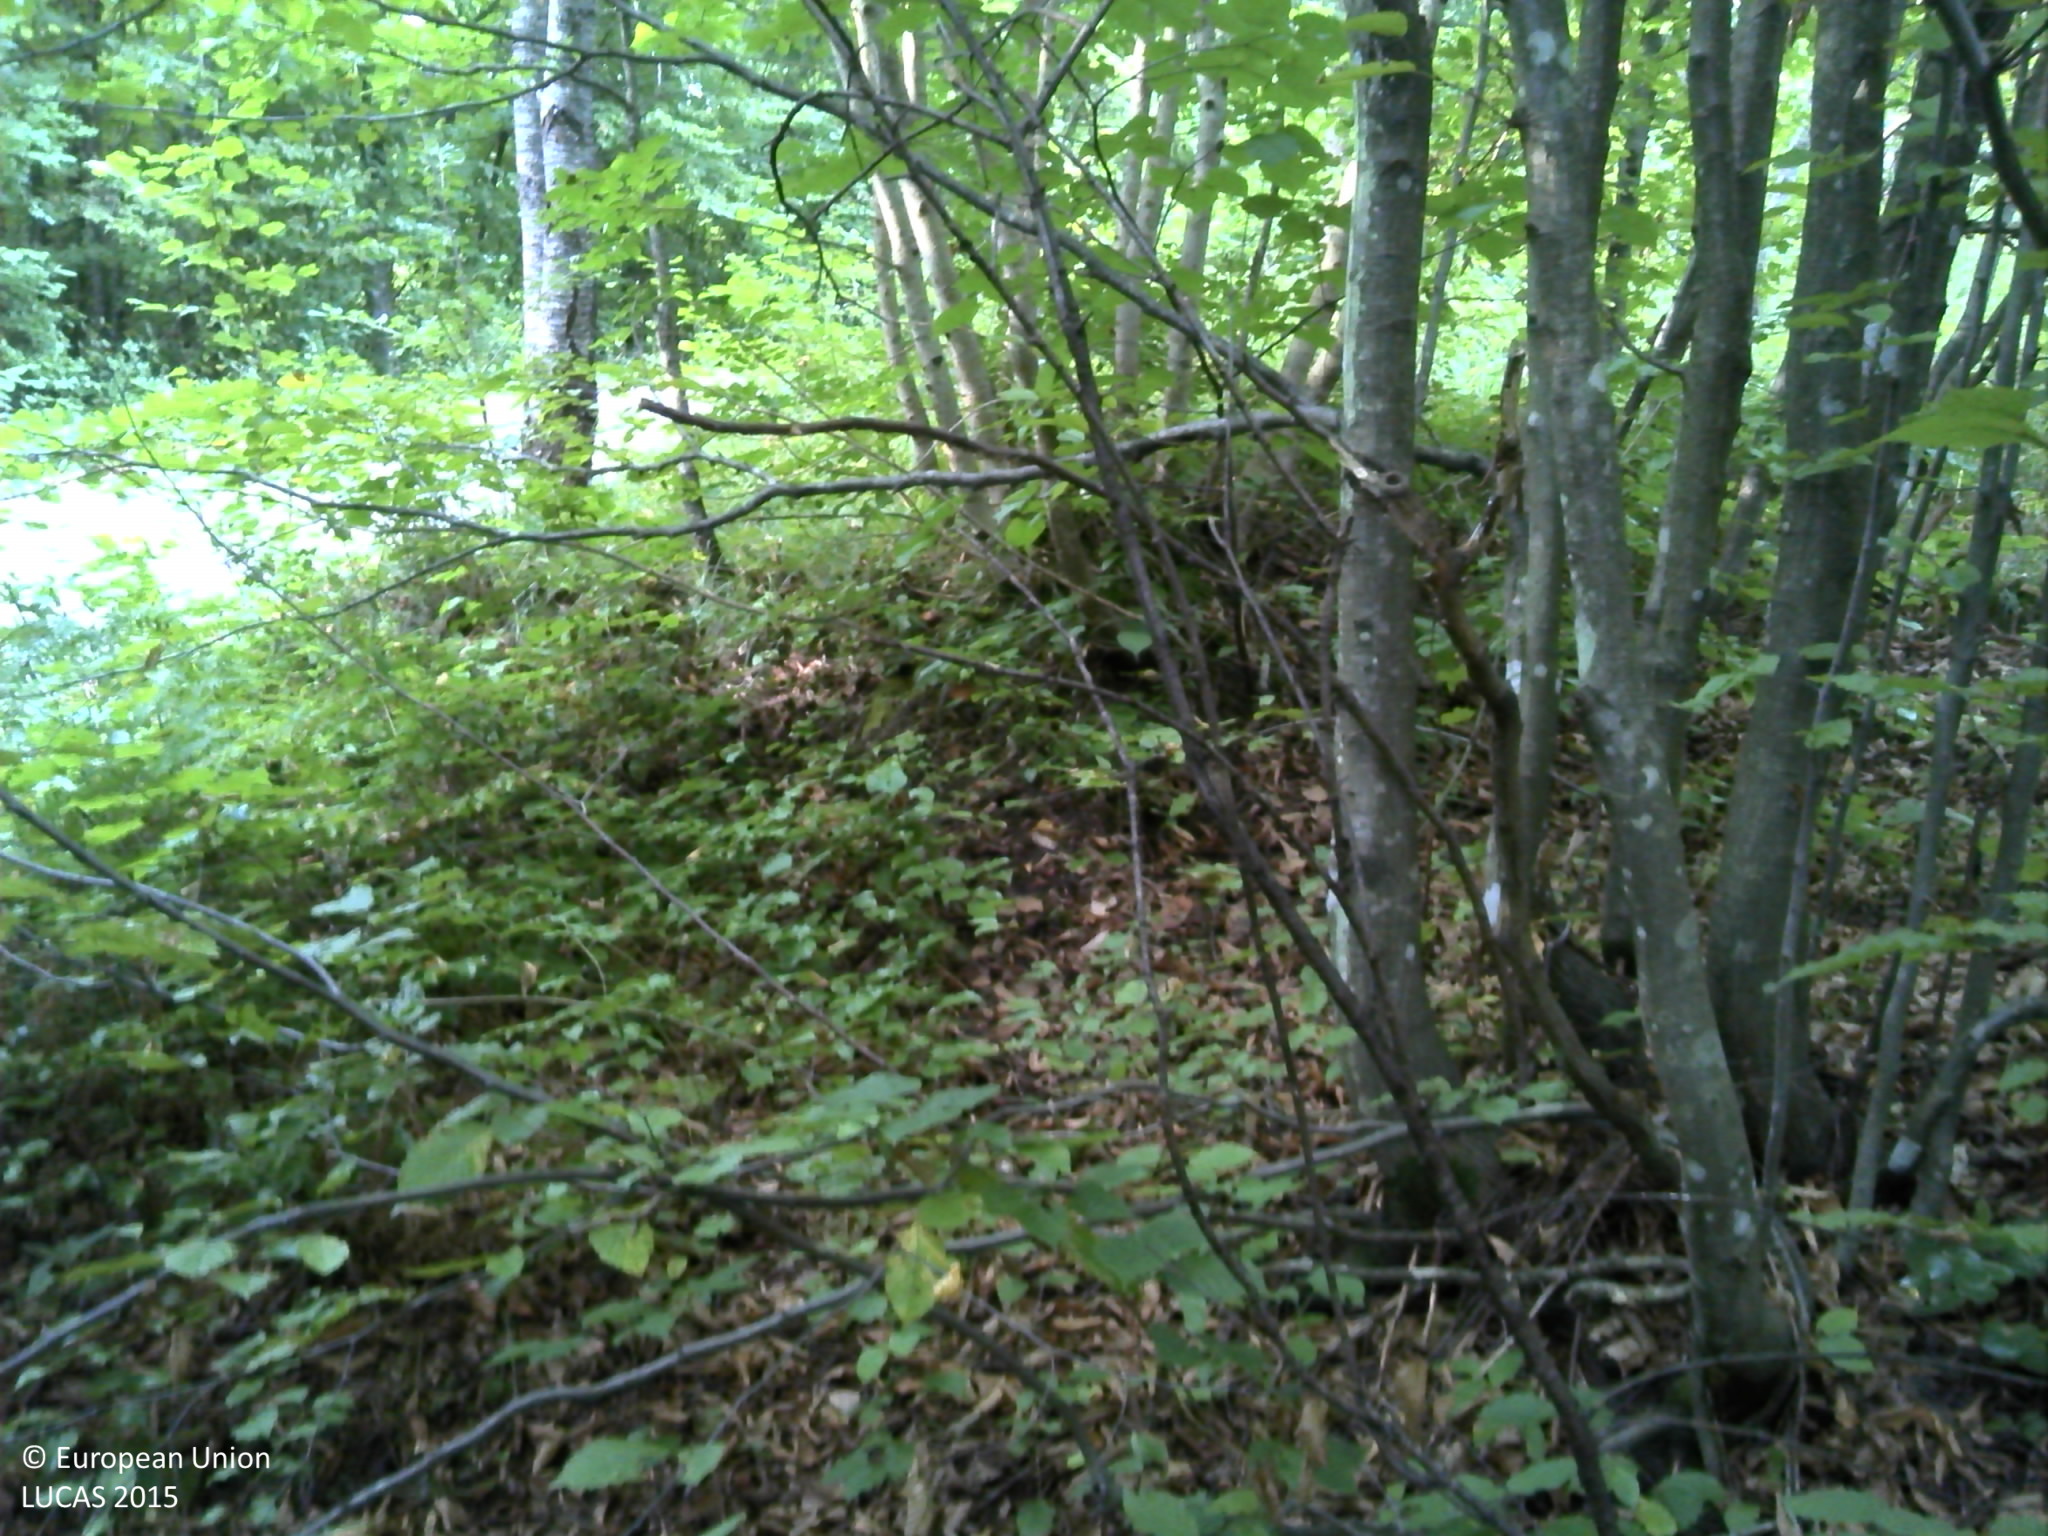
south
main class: Woodland
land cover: Broadleaved woodland
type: beech forest
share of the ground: > 75 %
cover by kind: broadleaved forest trees 100 %
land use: Forestry
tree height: > 5 m
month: September
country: HR
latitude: 45.2868
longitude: 15.1844
